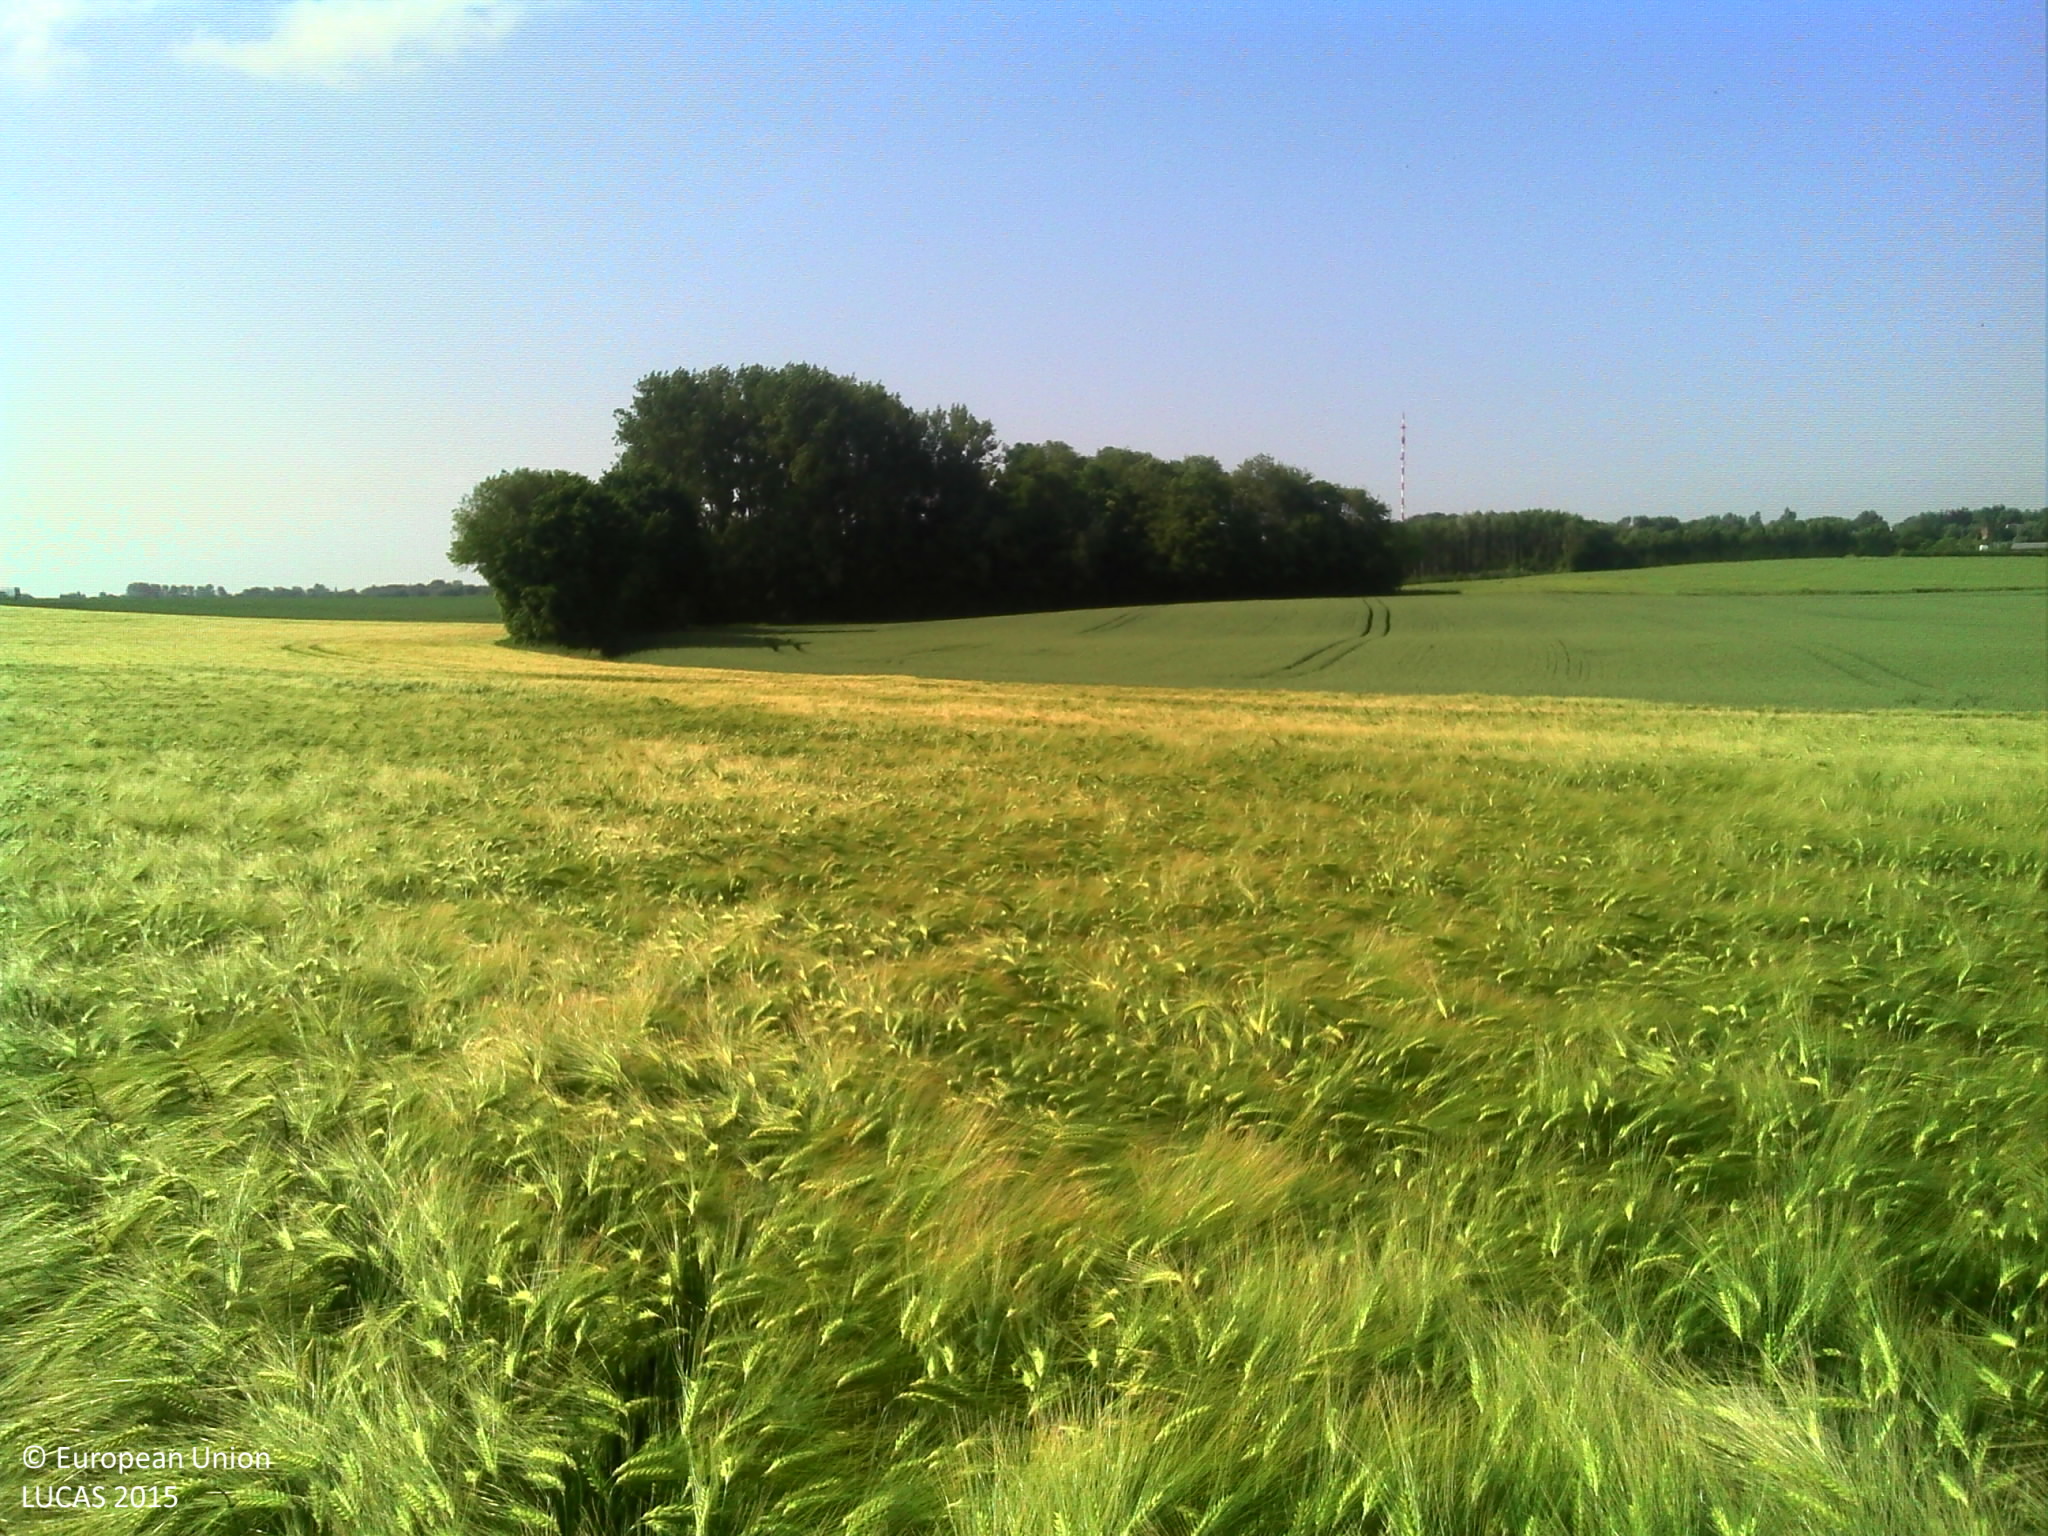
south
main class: Cropland
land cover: Barley
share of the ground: > 75 %
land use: Agriculture (excluding fallow land and kitchen gardens)
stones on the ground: < 10 %
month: June
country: FR
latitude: 49.8833
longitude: 4.0240
